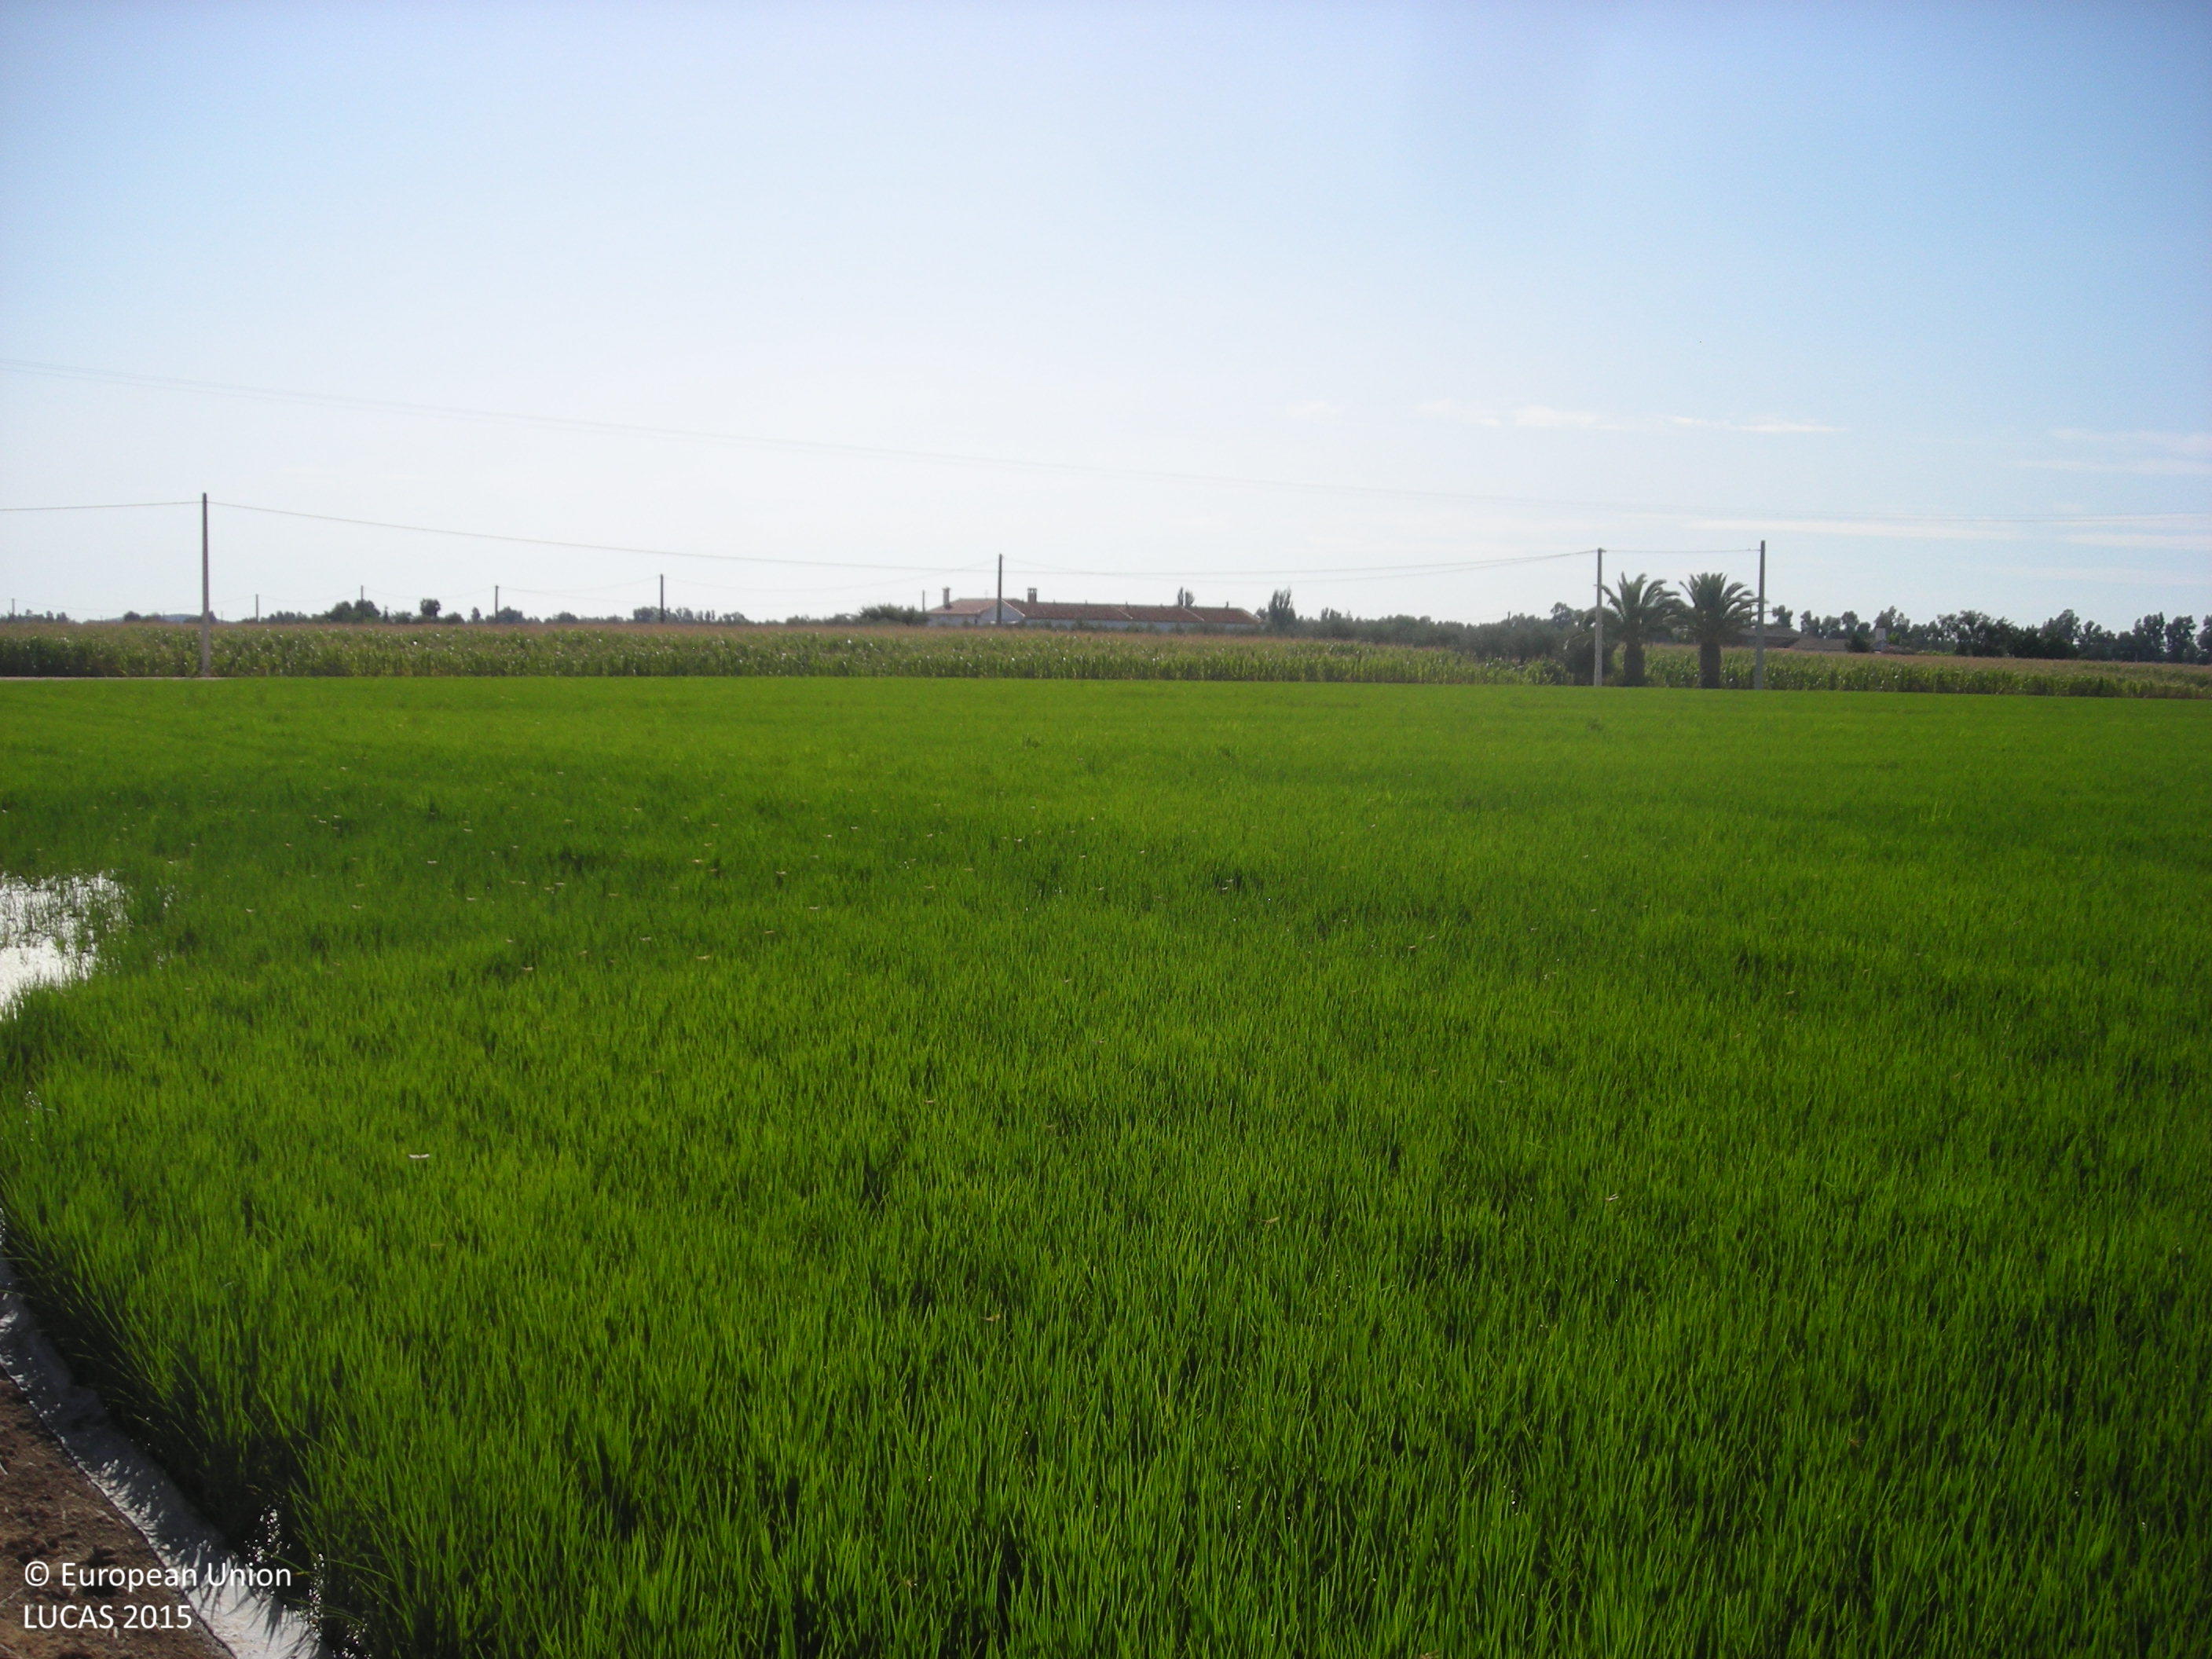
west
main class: Cropland
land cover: Tomatoes
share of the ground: > 75 %
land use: Agriculture (excluding fallow land and kitchen gardens)
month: July
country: ES
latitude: 39.0088
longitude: -5.8361
